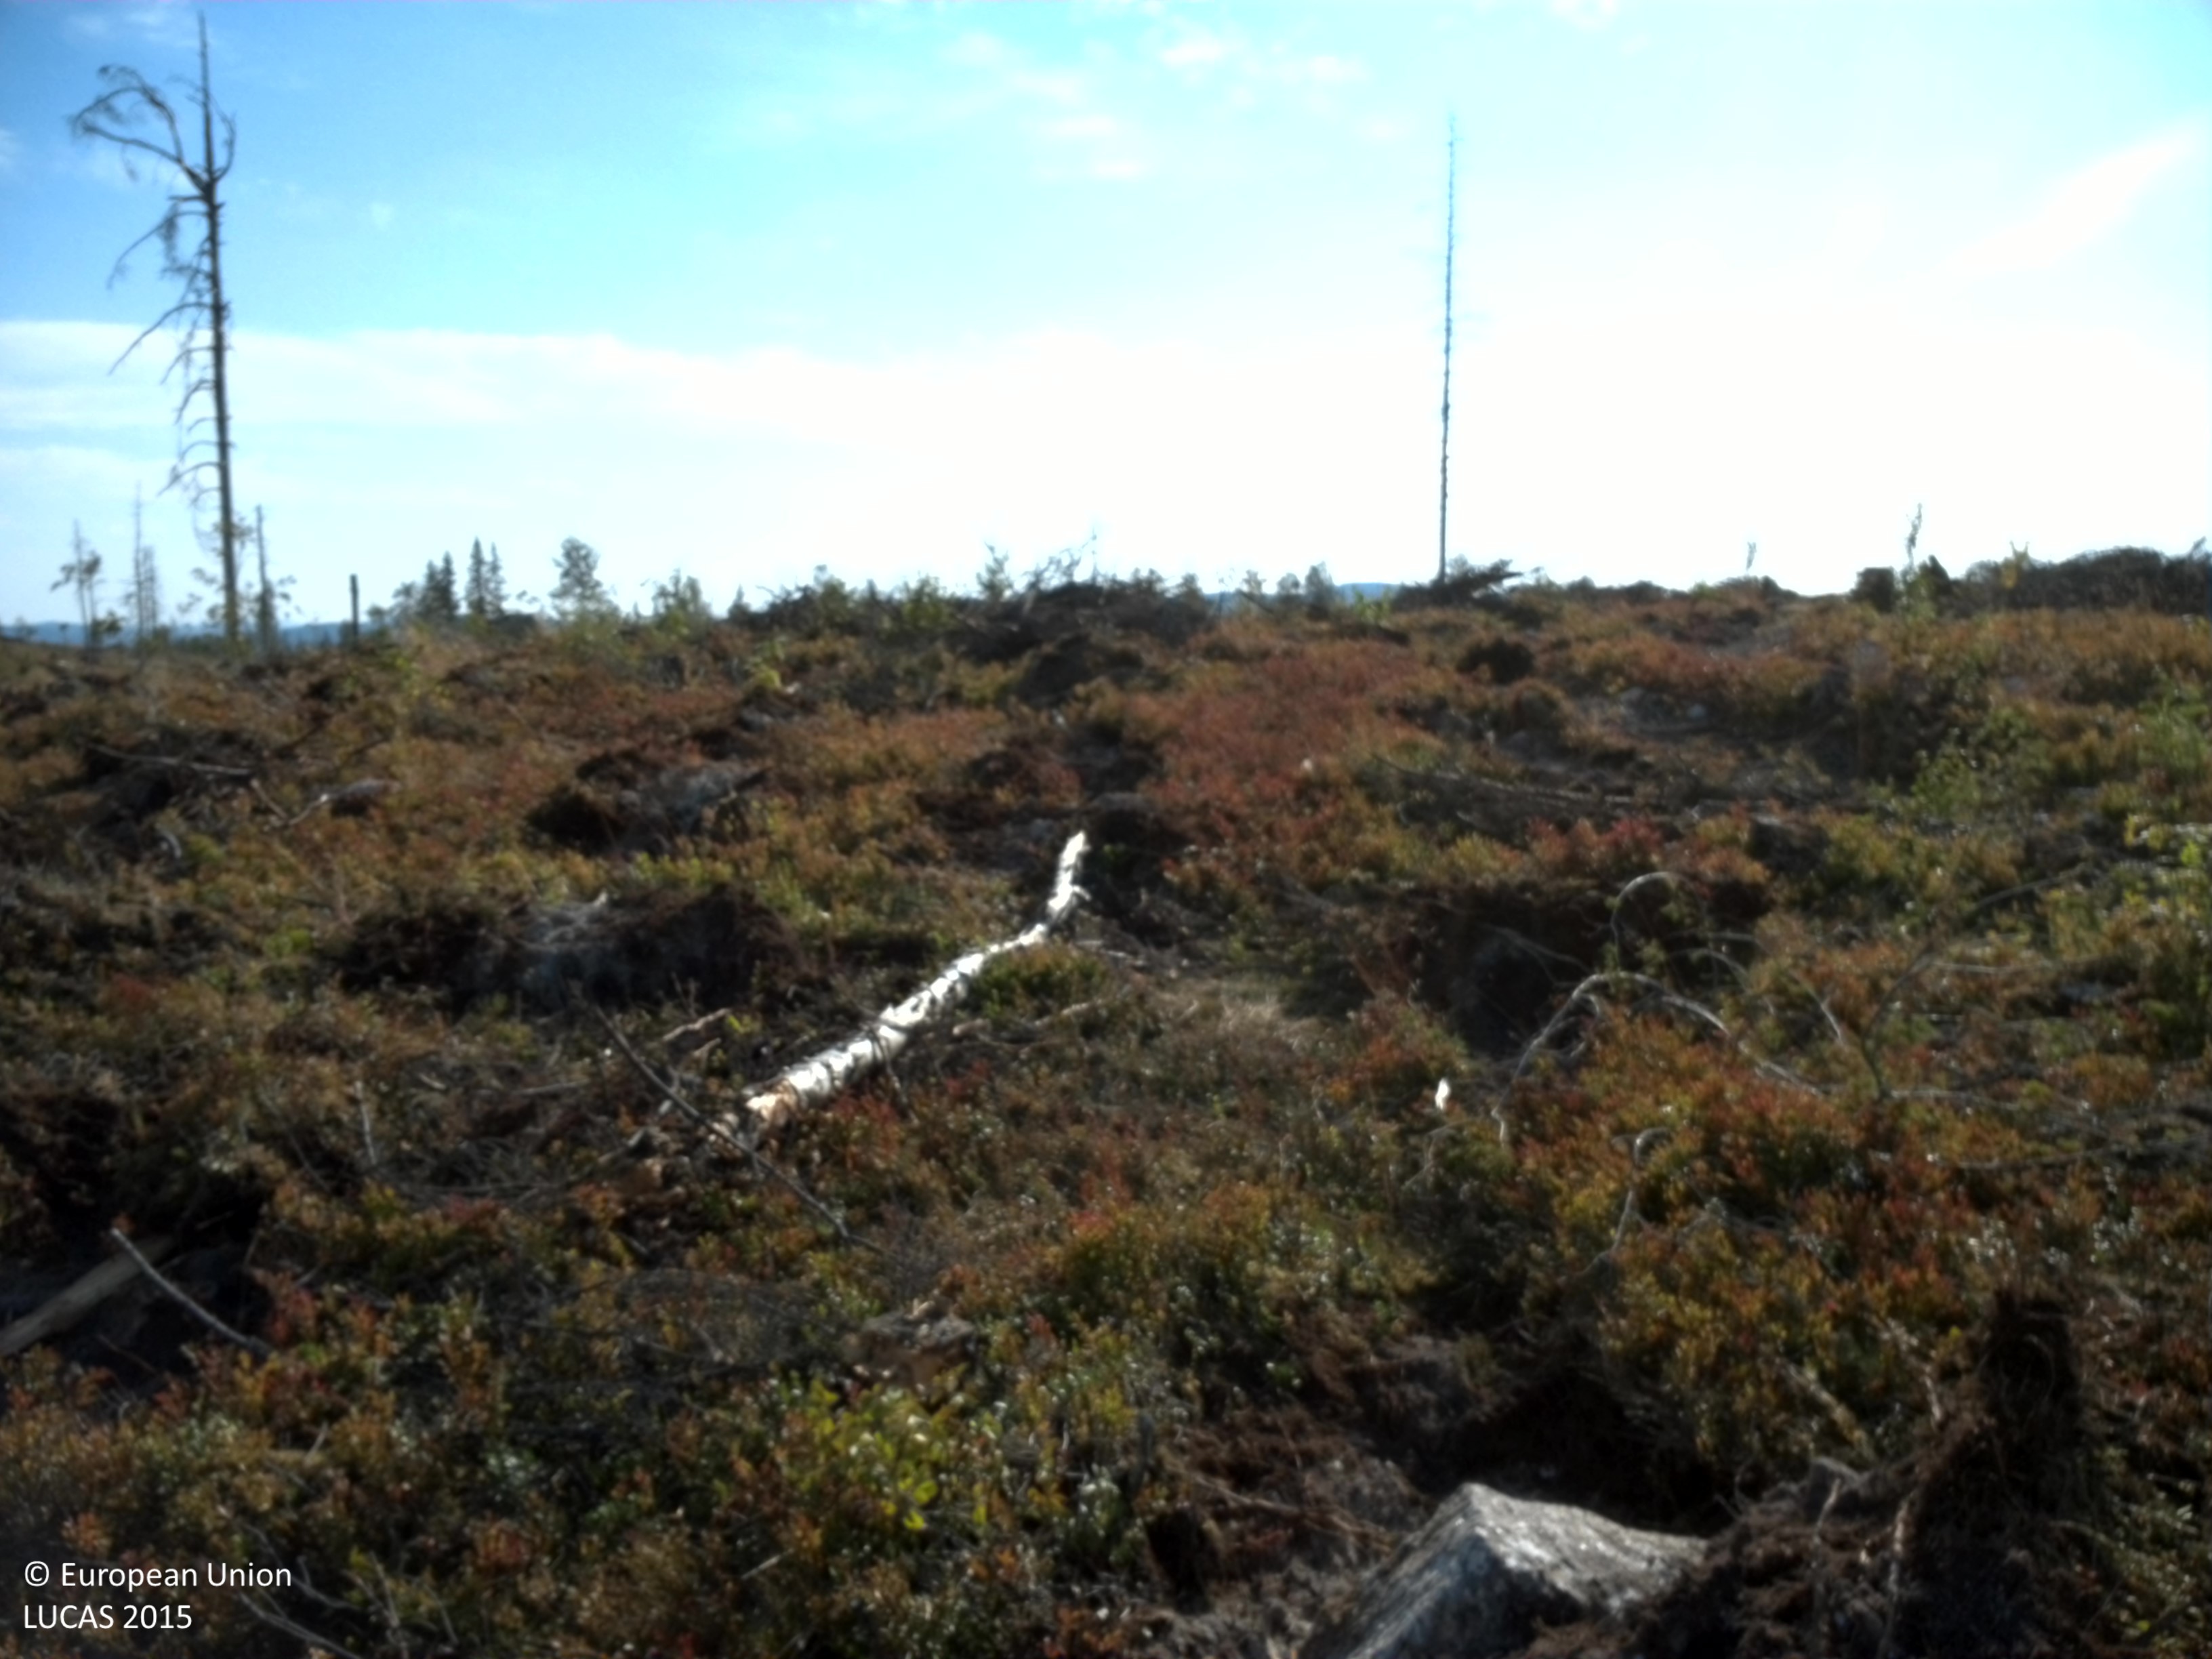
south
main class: Shrubland
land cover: Shrubland without tree cover
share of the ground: > 75 %
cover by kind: shrubs 80 %, consolidated bare surface 5 %, unconsolidated bare surface 5 %
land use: Forestry
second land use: Amenities, museums, leisure
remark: Clear cut
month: August
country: SE
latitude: 64.4983
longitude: 18.8165
